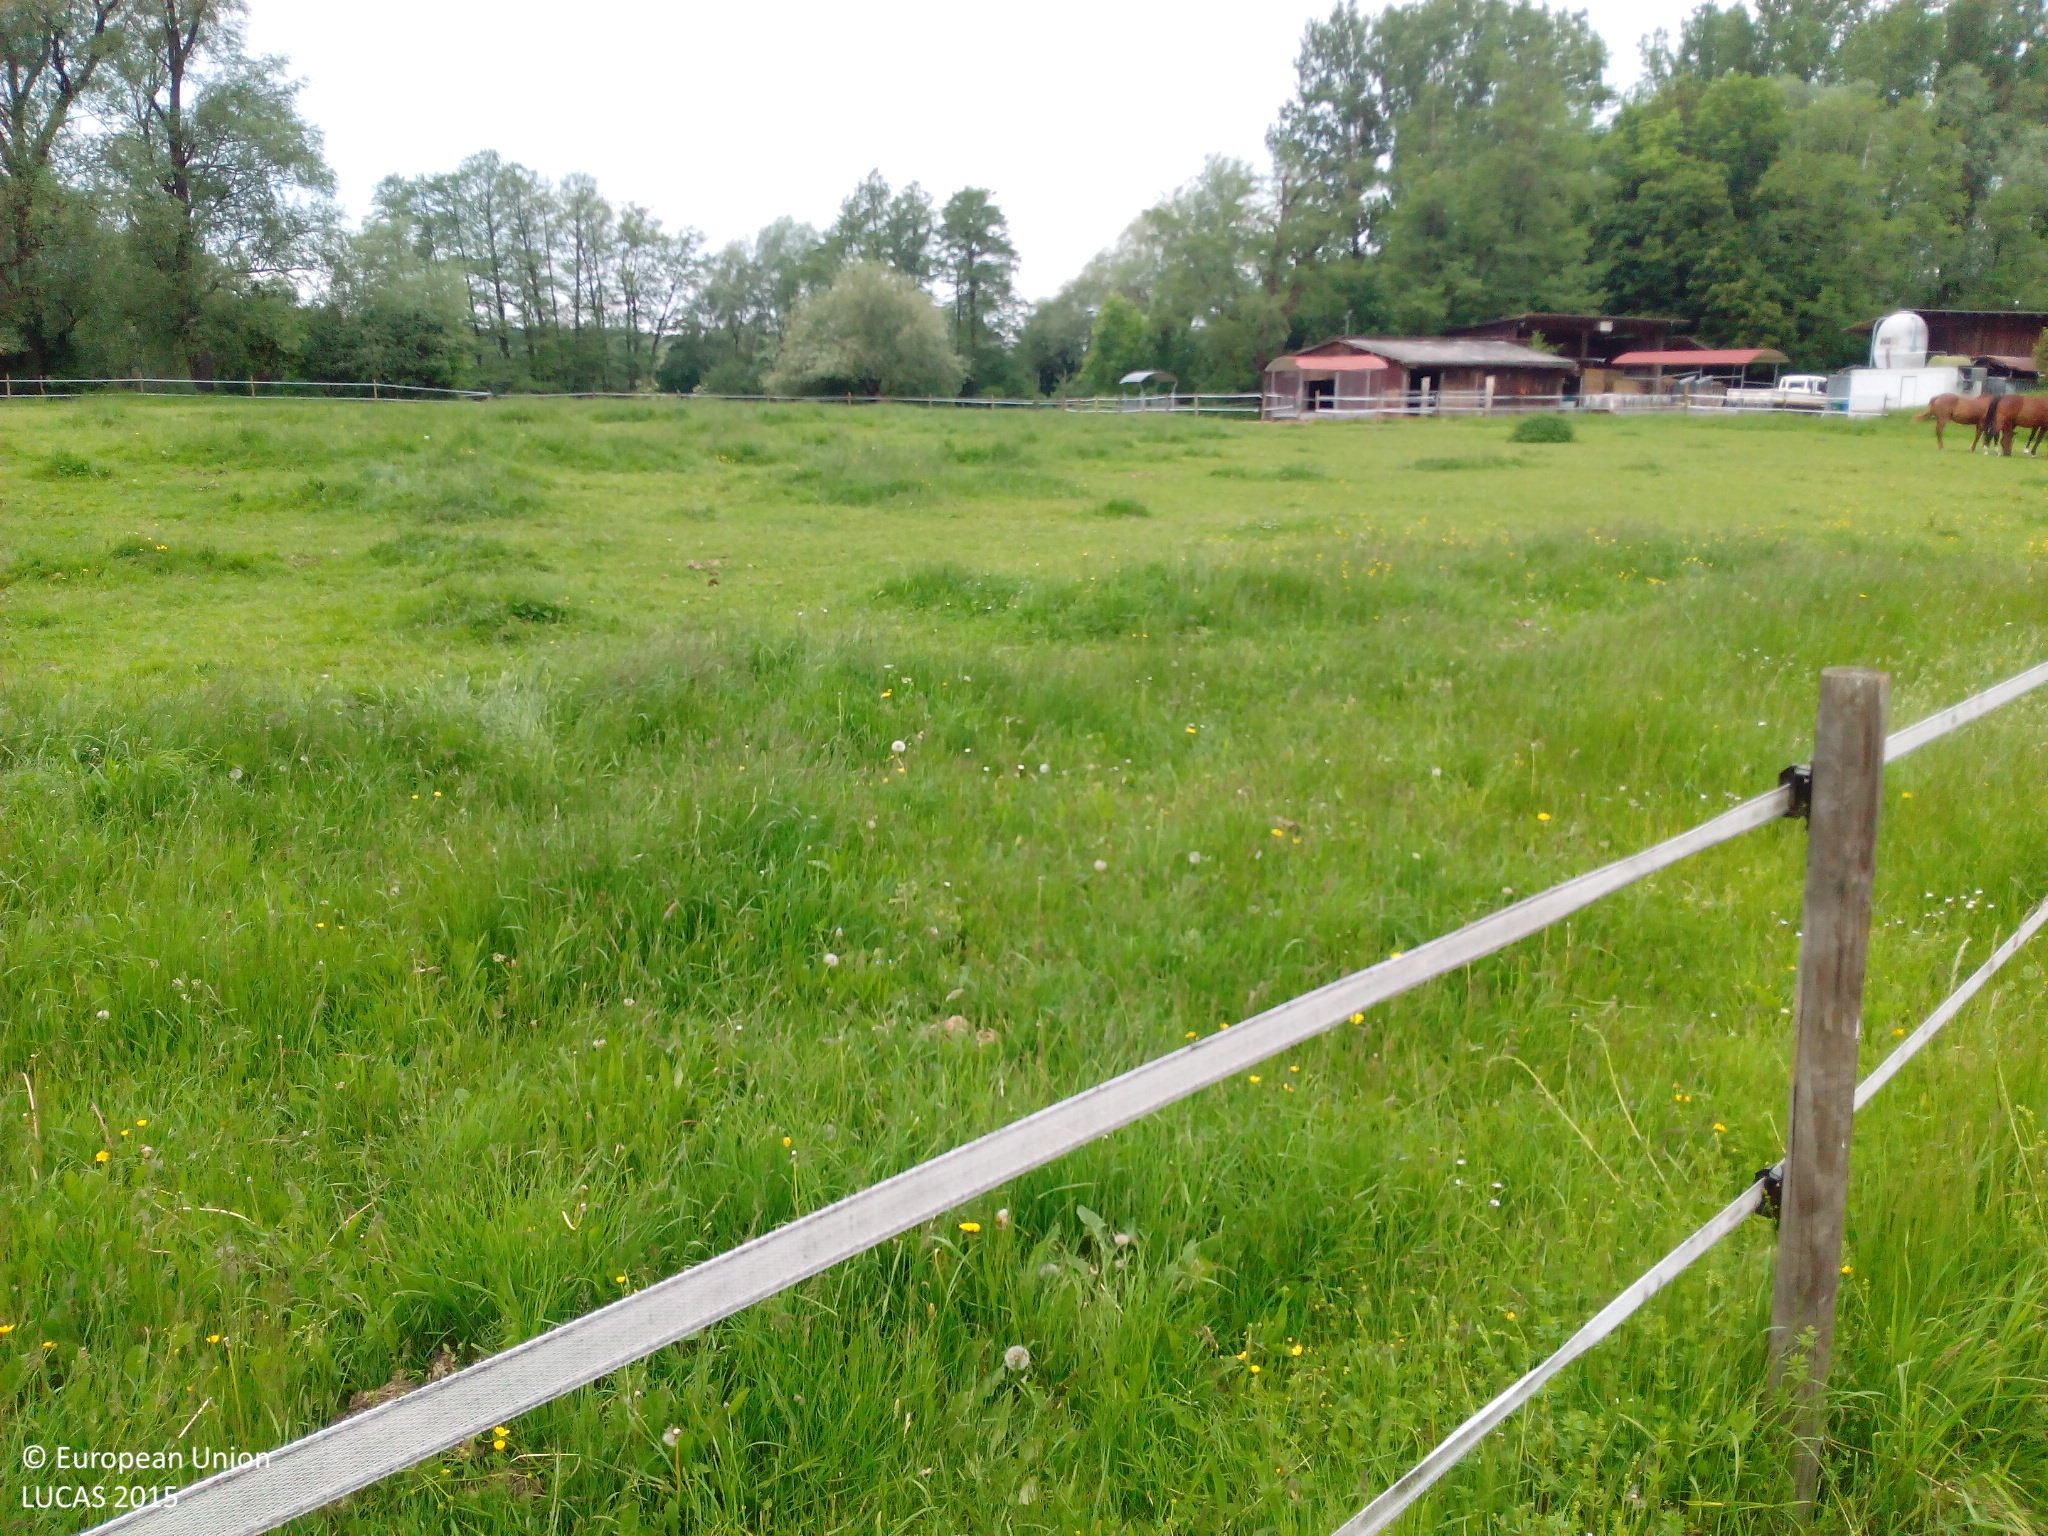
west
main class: Grassland
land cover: Grassland without tree/shrub cover
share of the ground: > 75 %
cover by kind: herbaceous plants 100 %
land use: Agriculture (excluding fallow land and kitchen gardens)
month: May
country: DE
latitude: 48.1333
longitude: 10.2551
